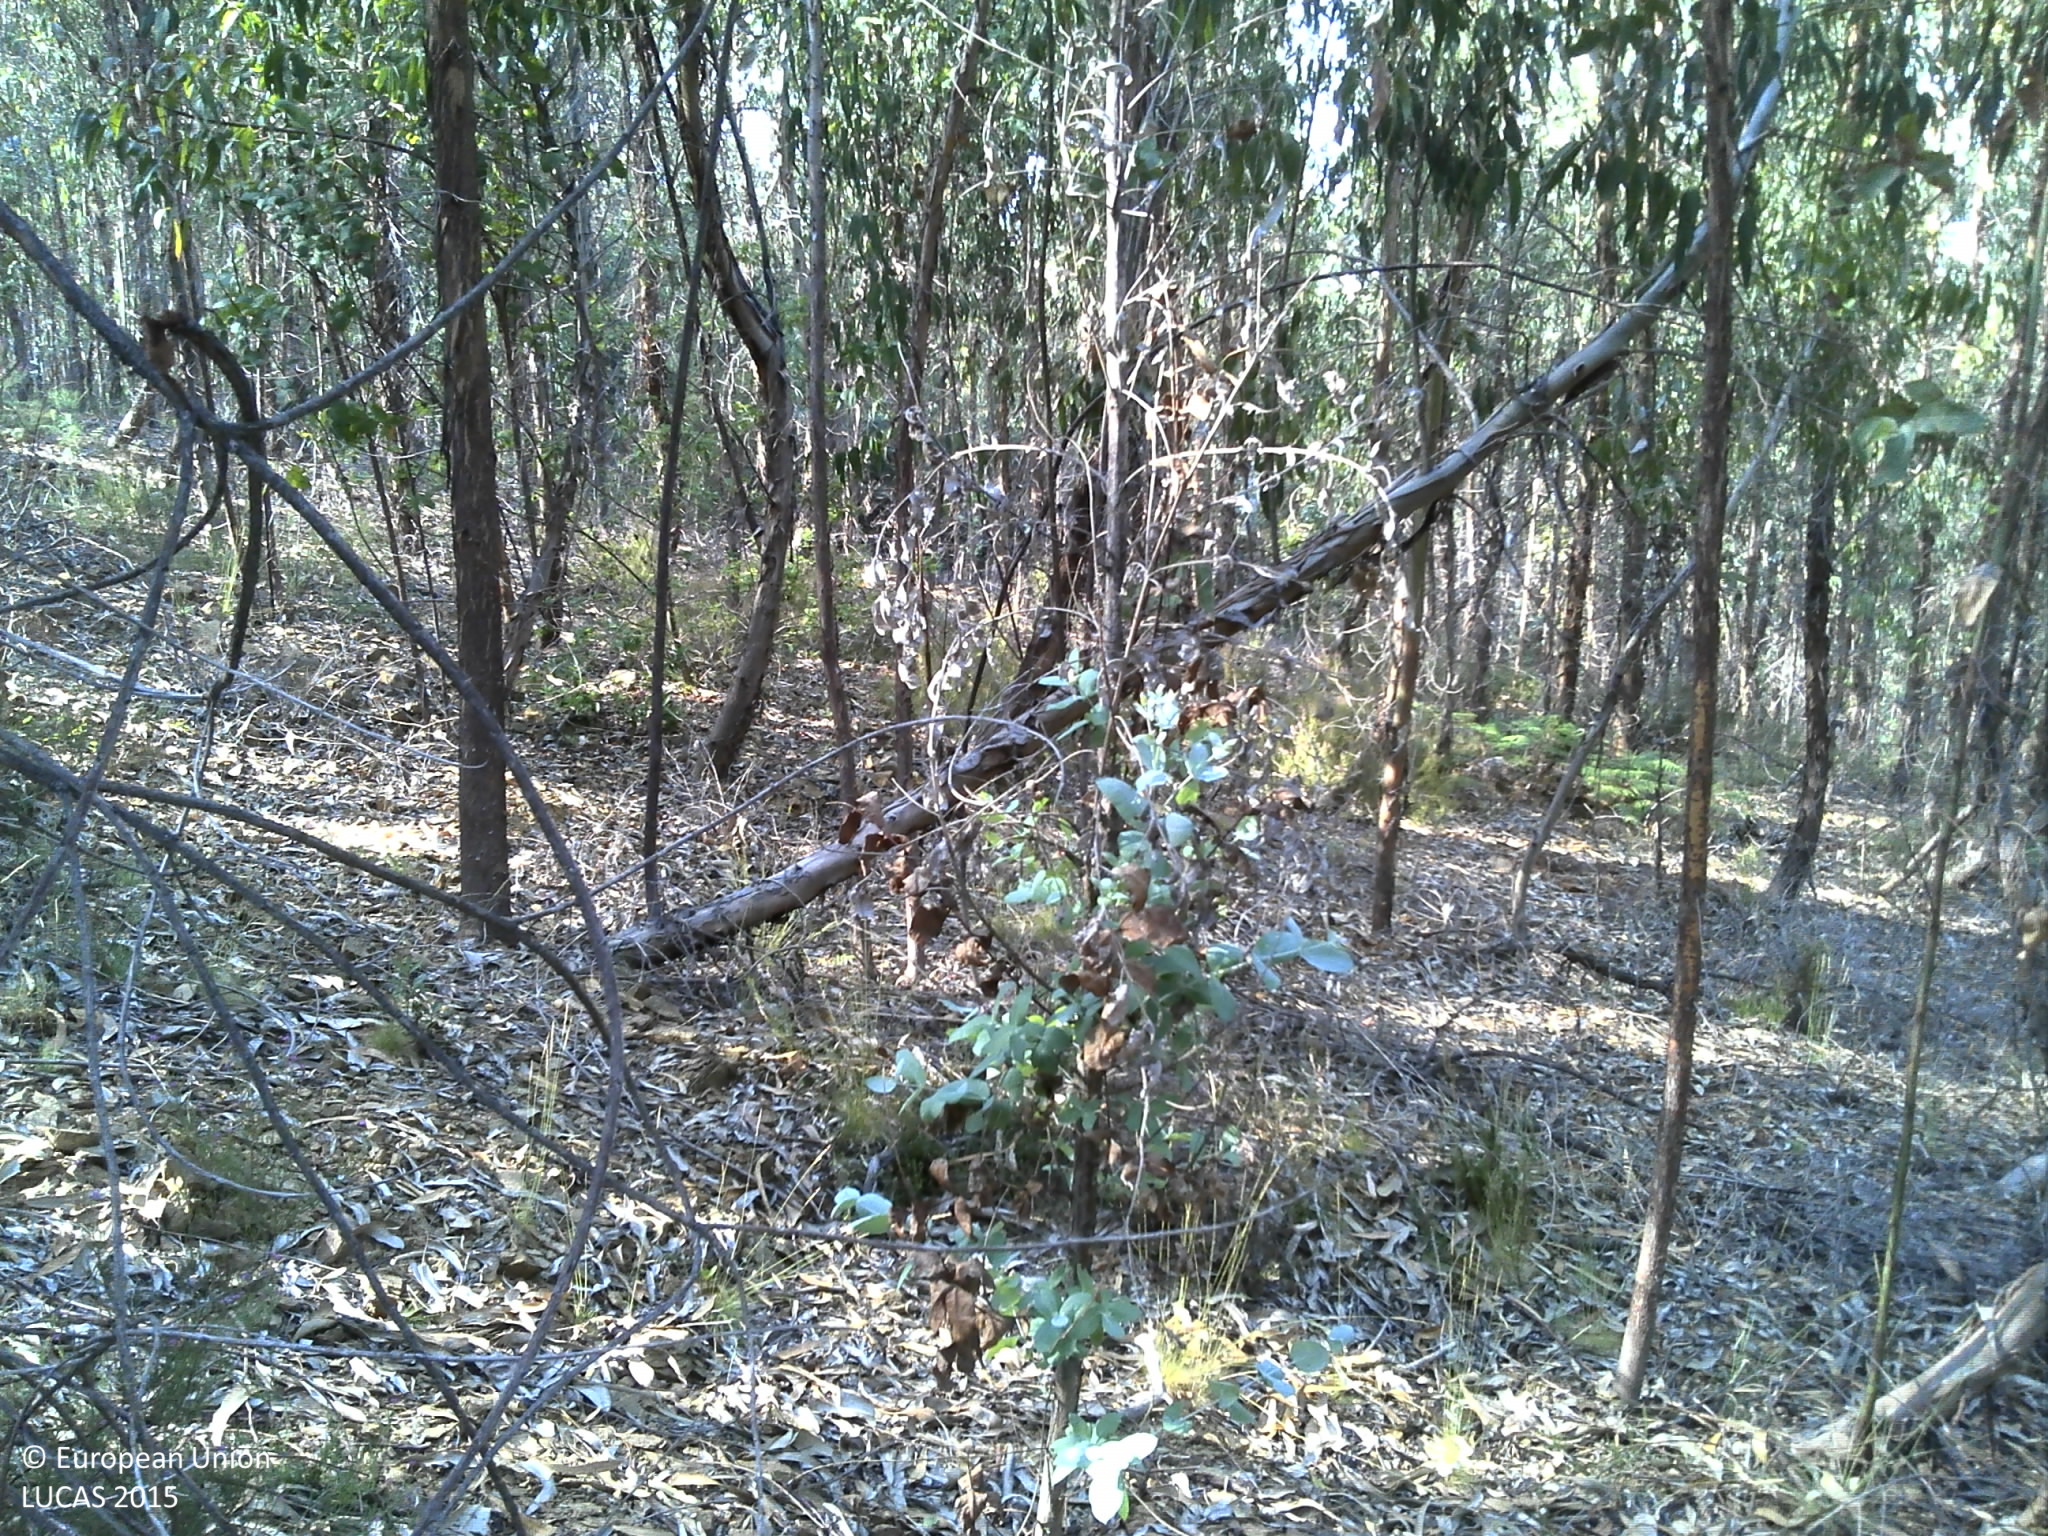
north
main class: Woodland
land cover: Broadleaved woodland
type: exotic forest
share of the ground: 25 - 50 %
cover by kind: unconsolidated bare surface 65 %, broadleaved forest trees 30 %, shrubs 5 %
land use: Forestry
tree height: > 5 m
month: June
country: PT
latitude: 39.9835
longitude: -8.1409
